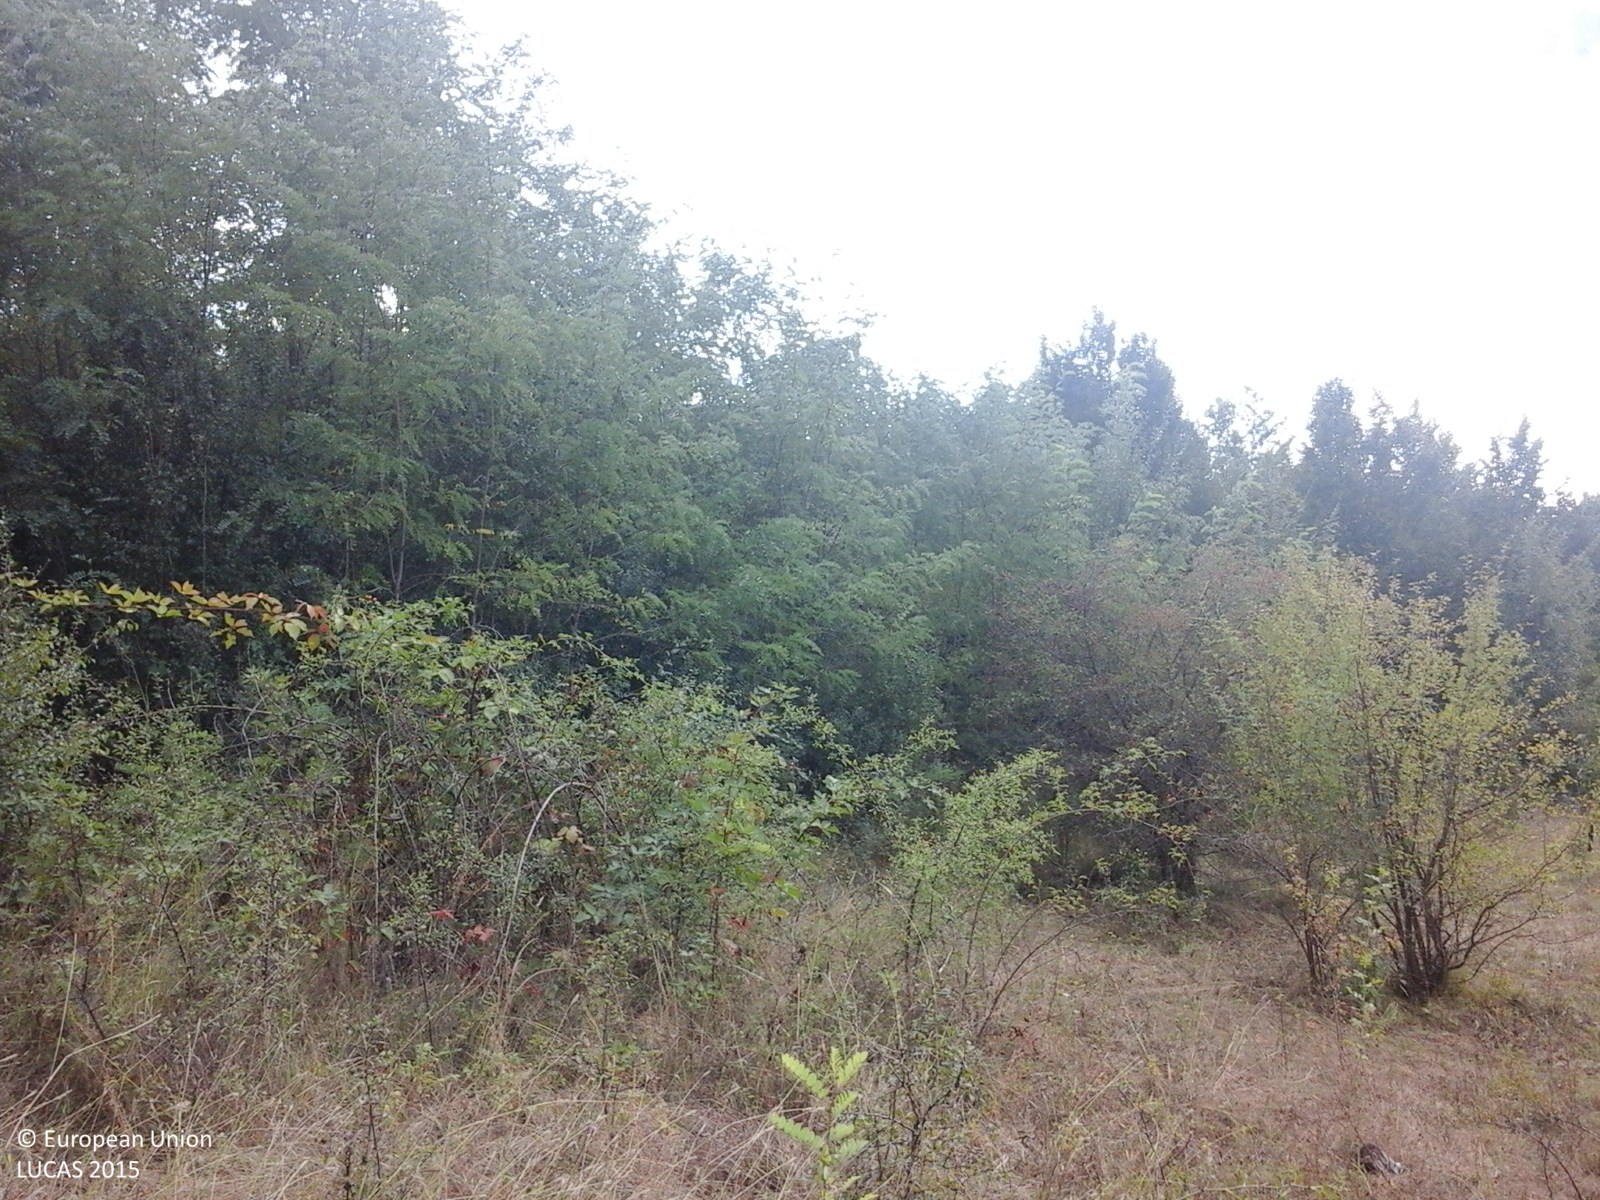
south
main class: Woodland
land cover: Broadleaved woodland
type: exotic forest
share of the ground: > 75 %
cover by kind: broadleaved forest trees 100 %
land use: Forestry
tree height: > 5 m
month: September
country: RO
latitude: 47.5373
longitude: 23.1803
